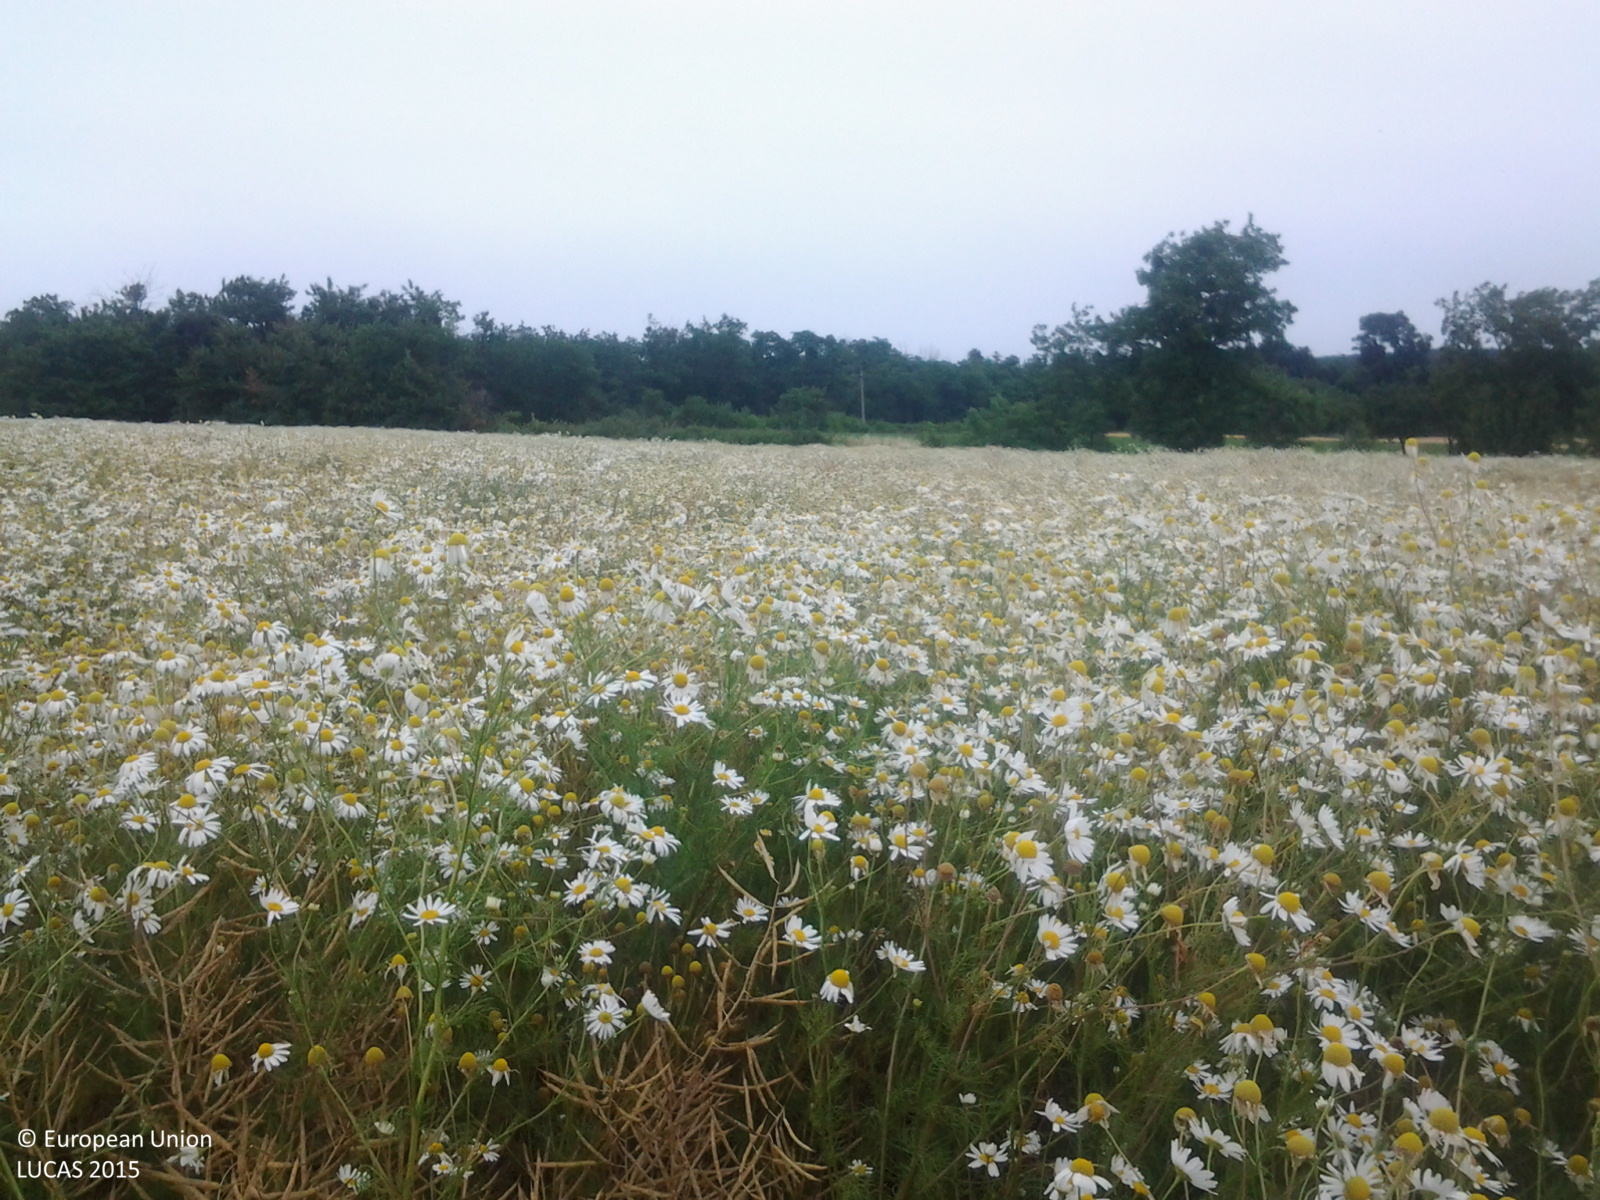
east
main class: Cropland
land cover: Rape and turnip rape
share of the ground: 50 - 75 %
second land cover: Other non-permanent industrial crops
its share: 25 - 50 %
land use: Agriculture (excluding fallow land and kitchen gardens)
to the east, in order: Rape and turnip rape; Other non-permanent industrial crops; Broadleaved woodland; Tracks; Broadleaved woodland; Electric lines; Broadleaved woodland; Electric lines; Grass margins; Paved roads, cycling and walking lanes; Grass margins; Inland fresh water bodies; Broadleaved woodland
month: June
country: HU
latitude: 46.9406
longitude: 17.1907
